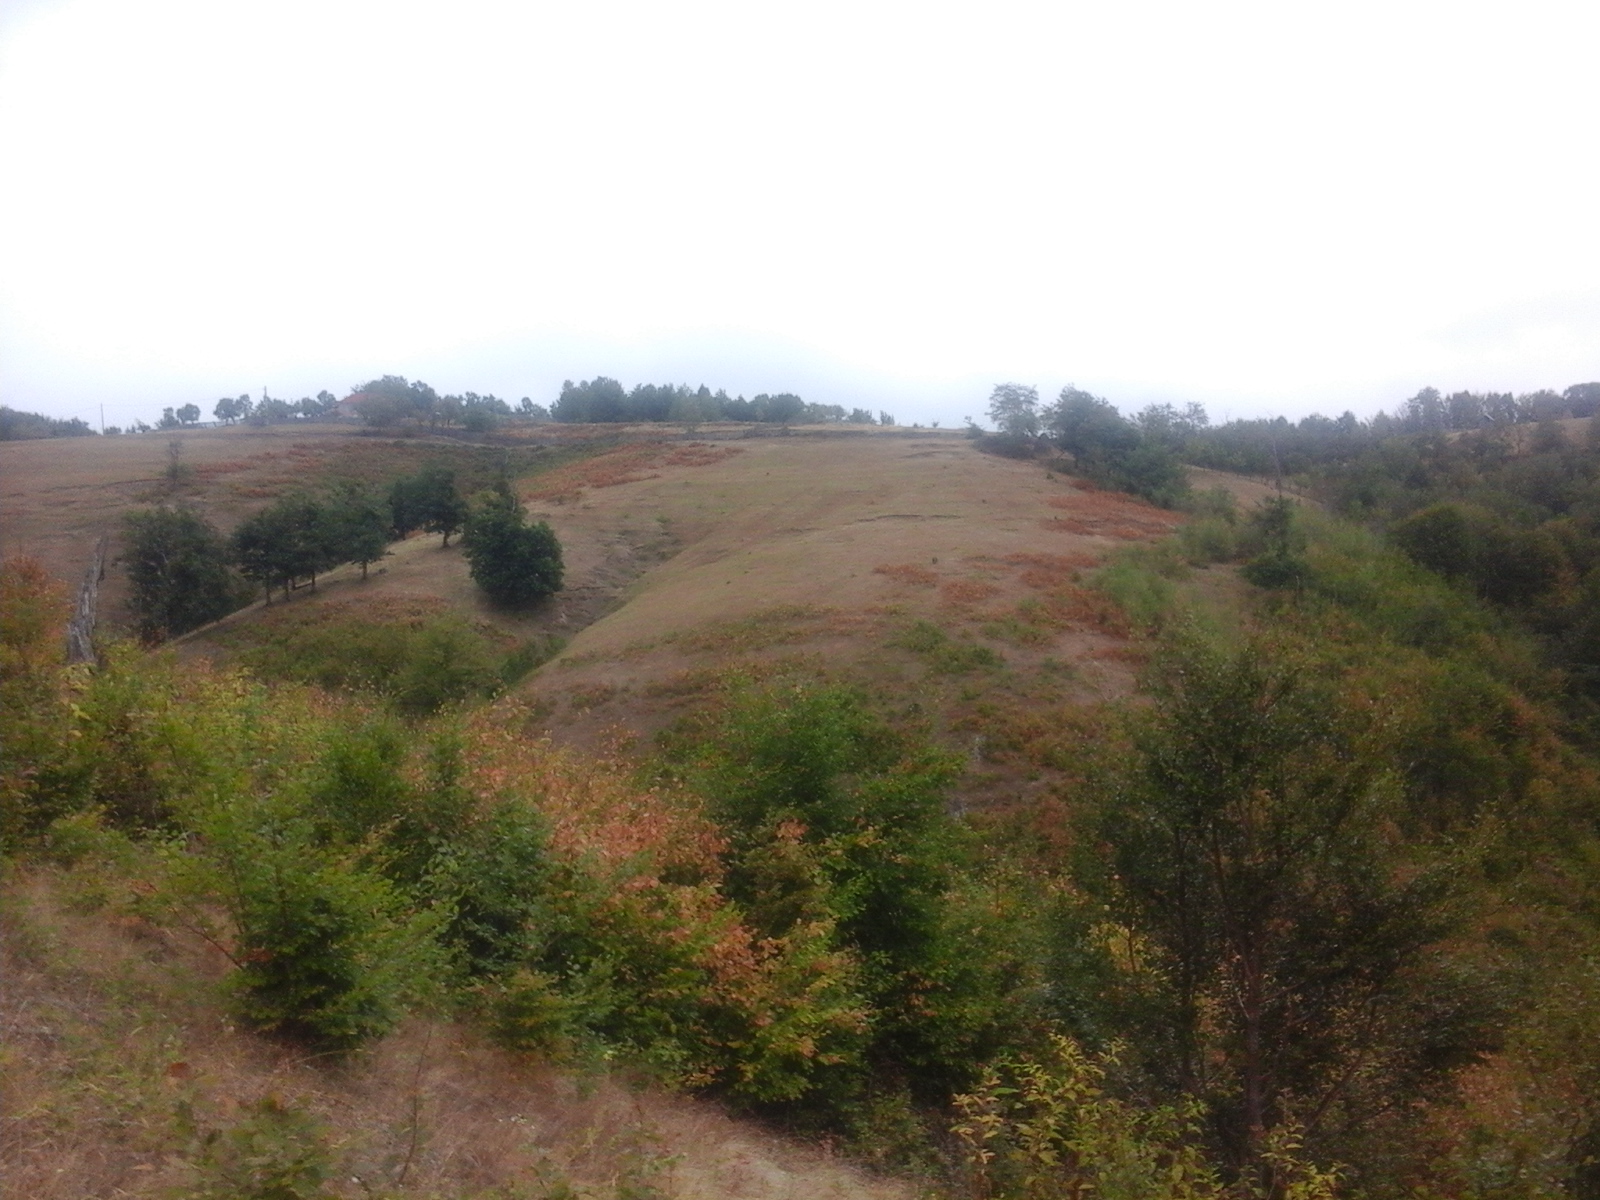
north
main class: Woodland
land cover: Broadleaved woodland
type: acidophilous oak and oak-birch forest
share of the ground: > 75 %
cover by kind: broadleaved forest trees 100 %
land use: Forestry
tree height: > 5 m
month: August
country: RO
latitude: 44.9395
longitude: 22.8072
